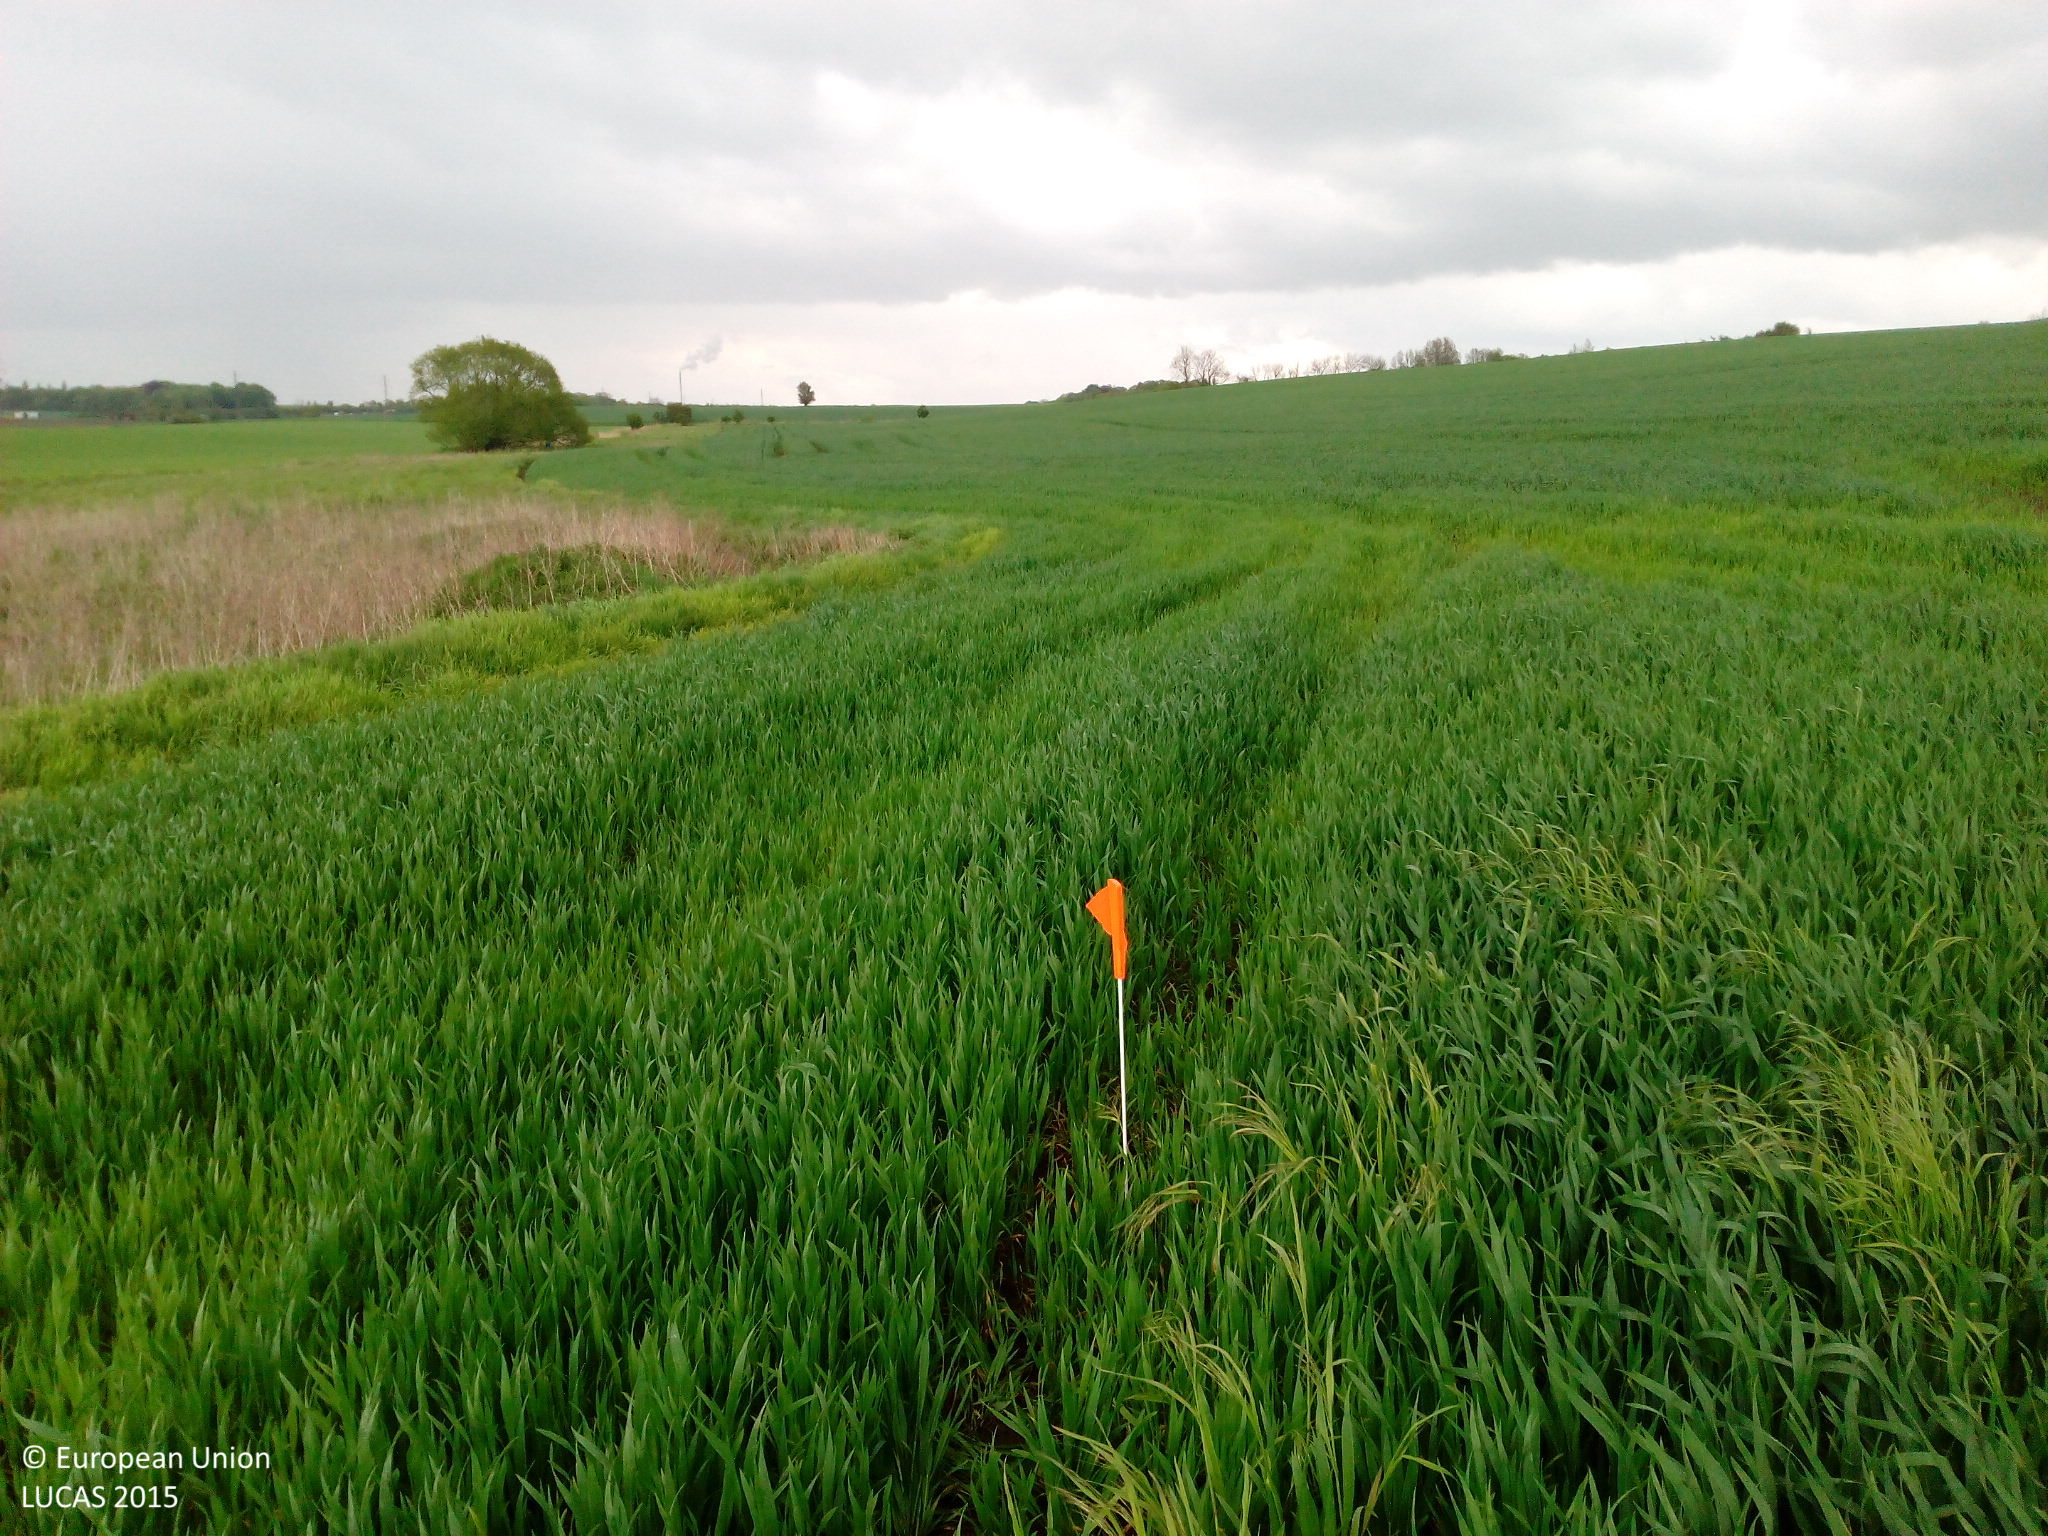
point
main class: Cropland
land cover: Common wheat
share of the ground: > 75 %
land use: Agriculture (excluding fallow land and kitchen gardens)
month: May
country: DK
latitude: 55.6150
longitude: 11.9829
